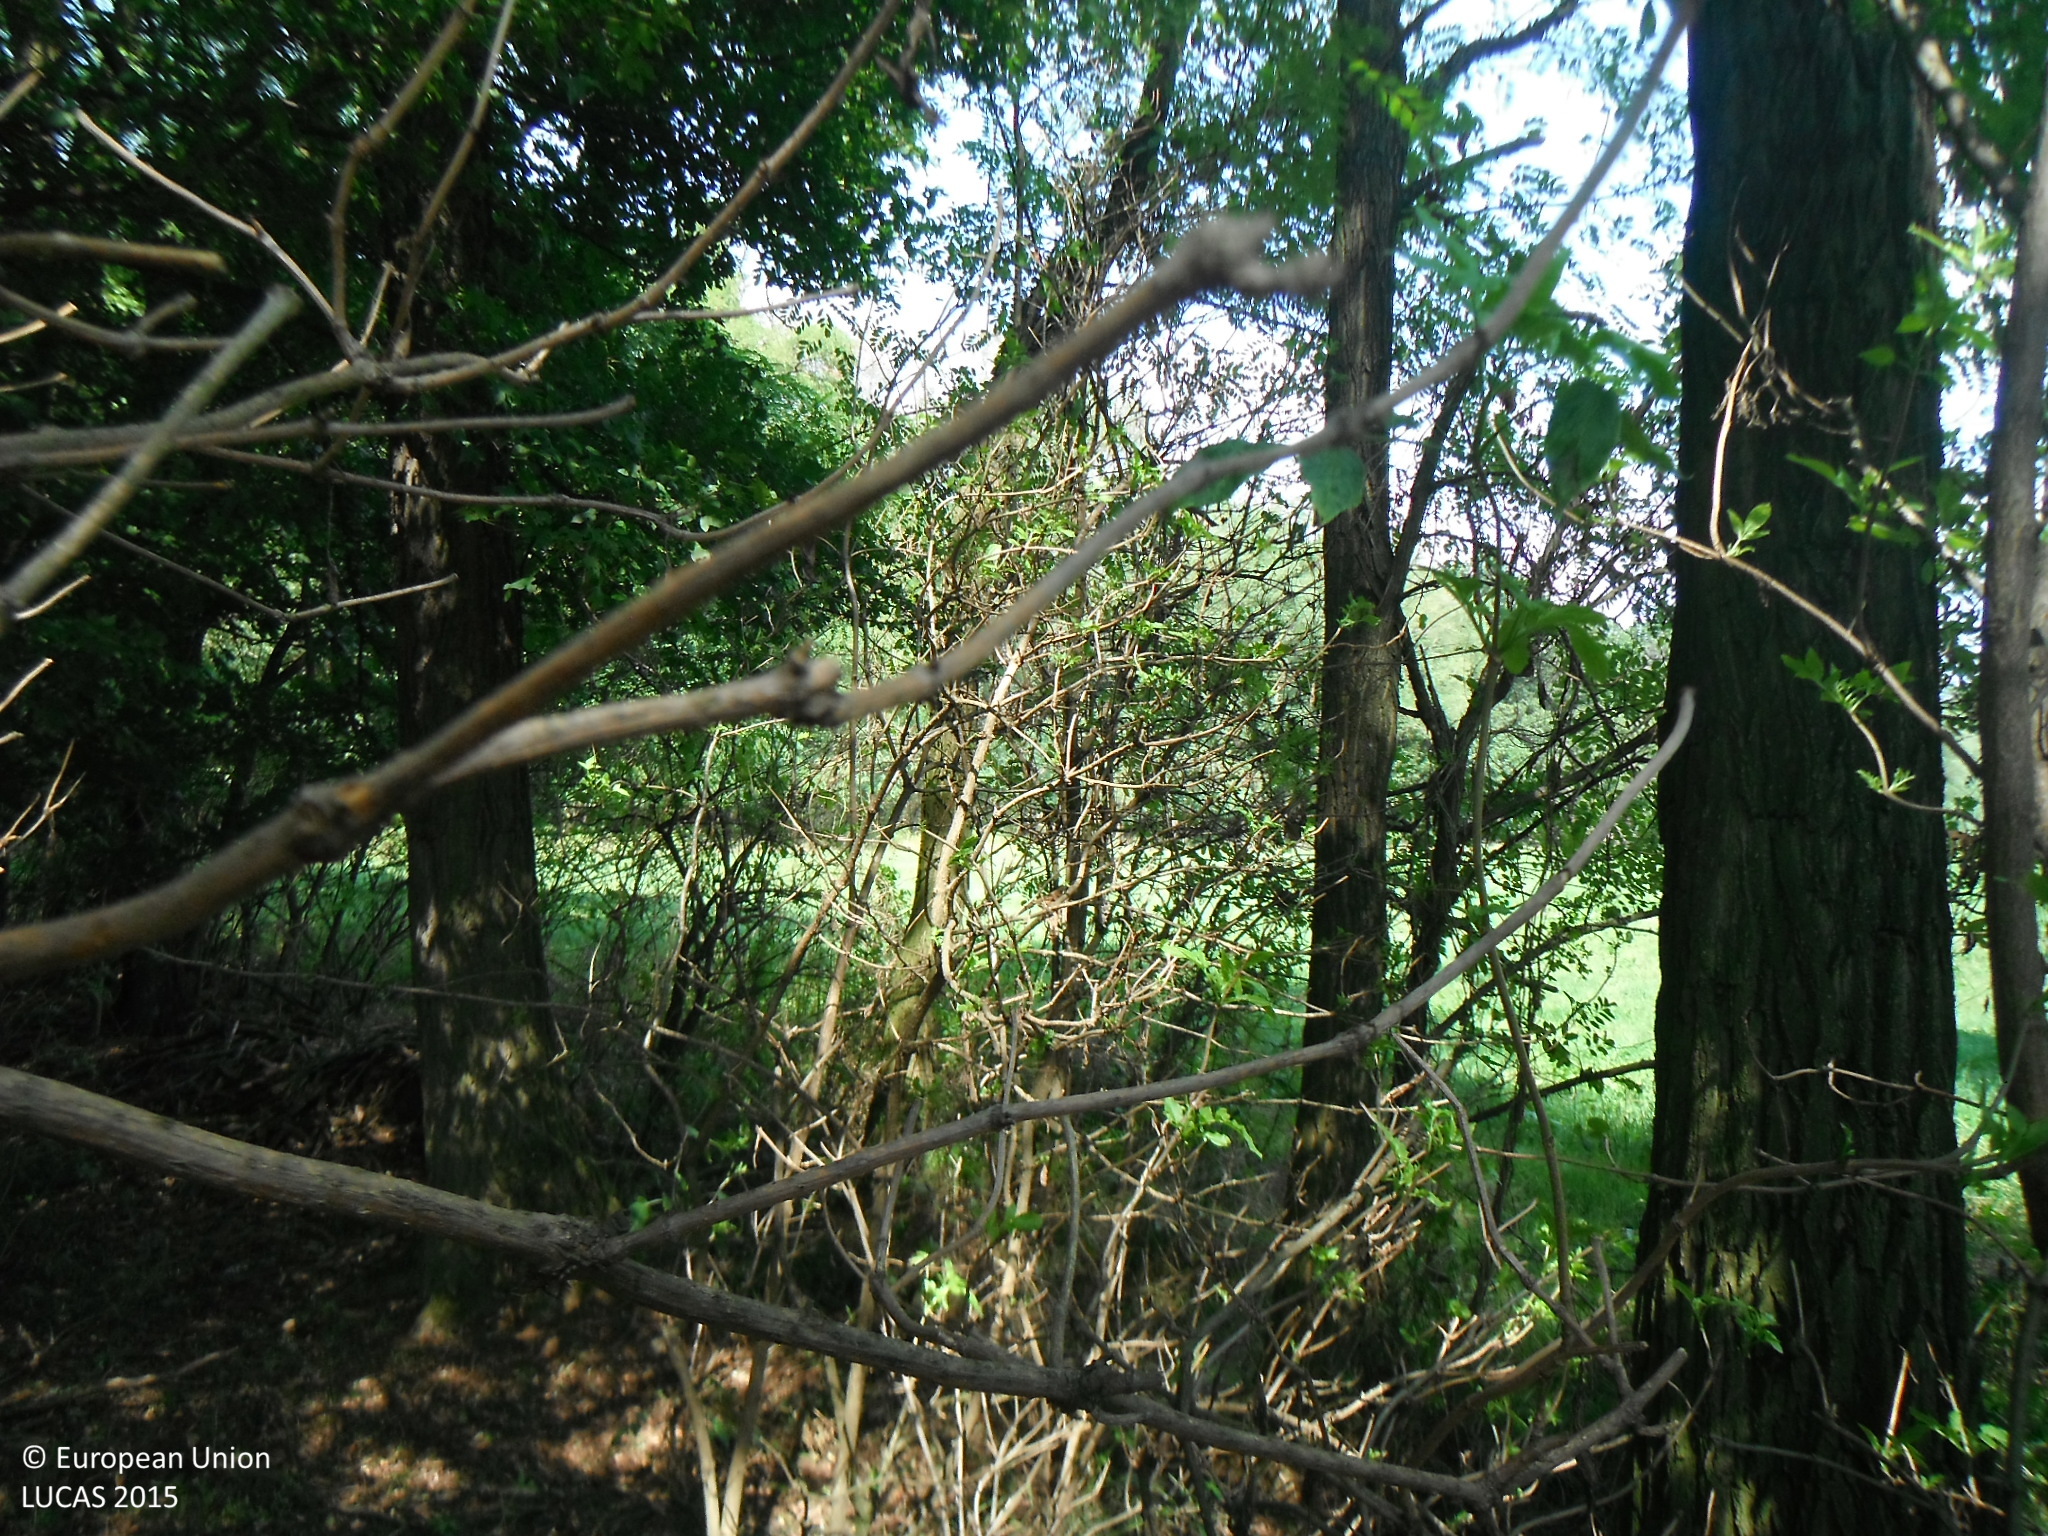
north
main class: Woodland
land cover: Broadleaved woodland
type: mesophytic deciduous forest
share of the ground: > 75 %
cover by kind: broadleaved forest trees 80 %, shrubs 10 %, herbaceous plants 10 %
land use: Forestry
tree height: > 5 m
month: September
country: SK
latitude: 48.7124
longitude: 17.4448
